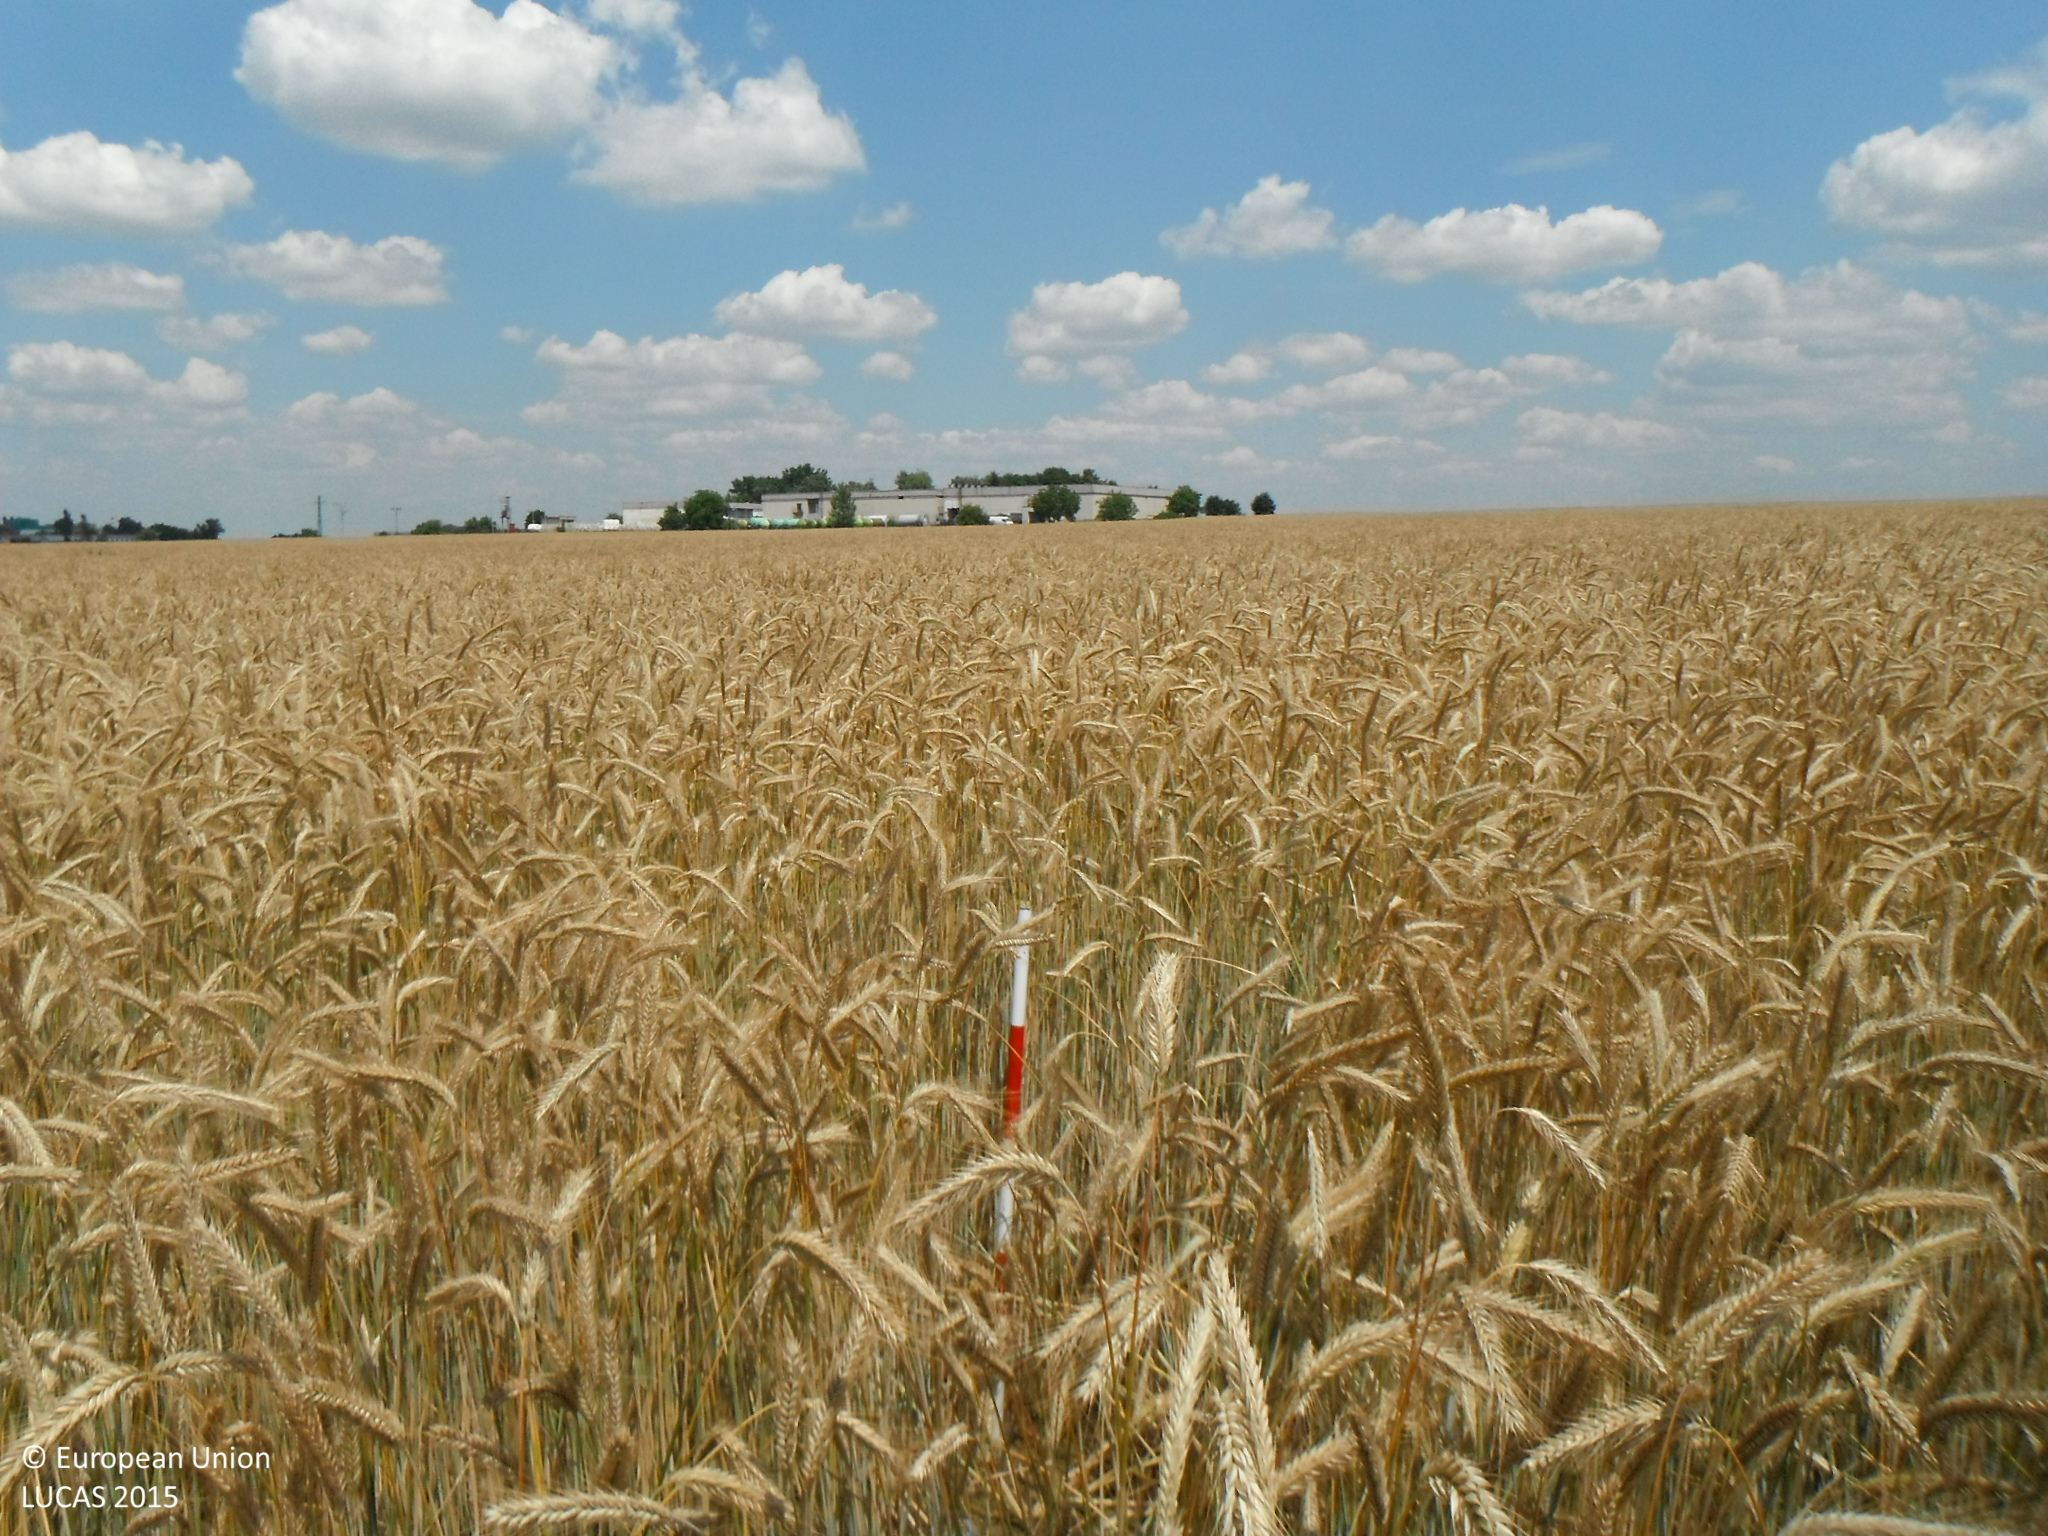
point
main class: Cropland
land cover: Triticale
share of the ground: > 75 %
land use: Agriculture (excluding fallow land and kitchen gardens)
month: June
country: SK
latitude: 47.8629
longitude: 18.2073
